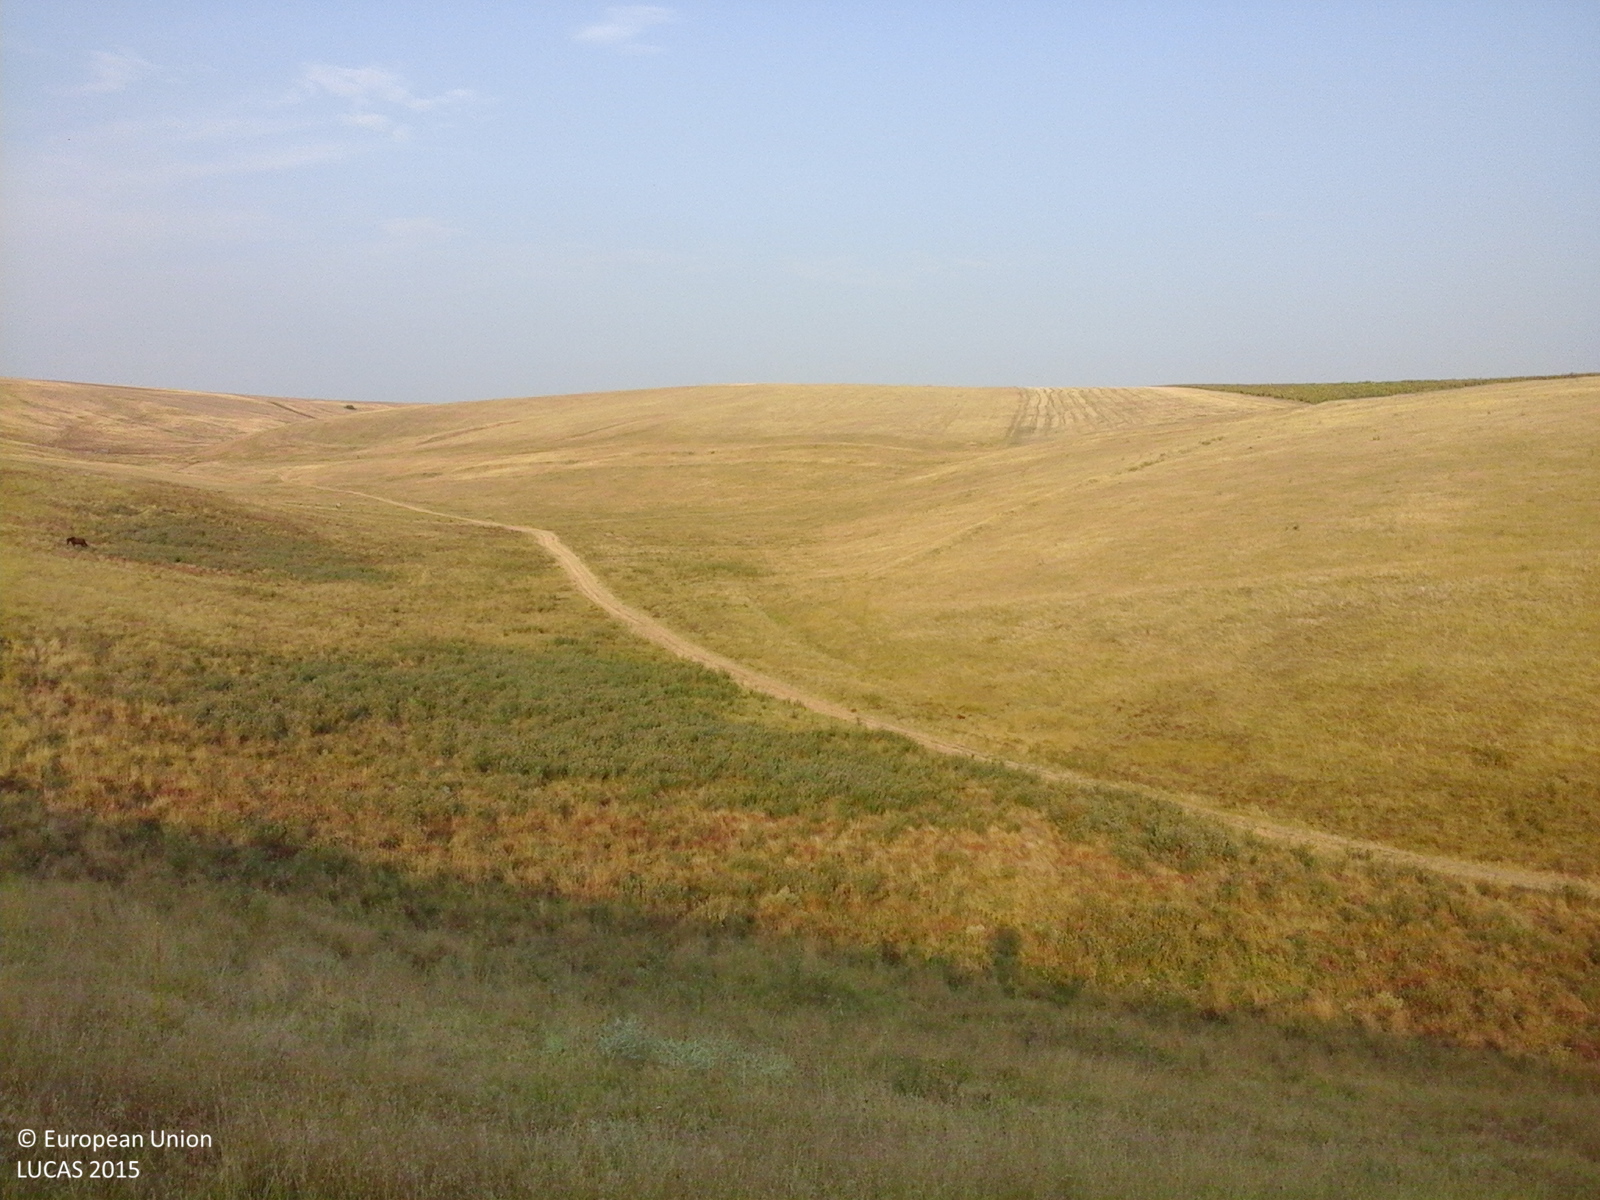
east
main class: Grassland
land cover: Grassland without tree/shrub cover
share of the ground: > 75 %
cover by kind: herbaceous plants 100 %
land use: Agriculture (excluding fallow land and kitchen gardens)
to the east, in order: Grassland without tree/shrub cover; Tracks; Grassland without tree/shrub cover; Tracks; Grassland without tree/shrub cover
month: August
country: RO
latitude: 44.2662
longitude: 23.0855
